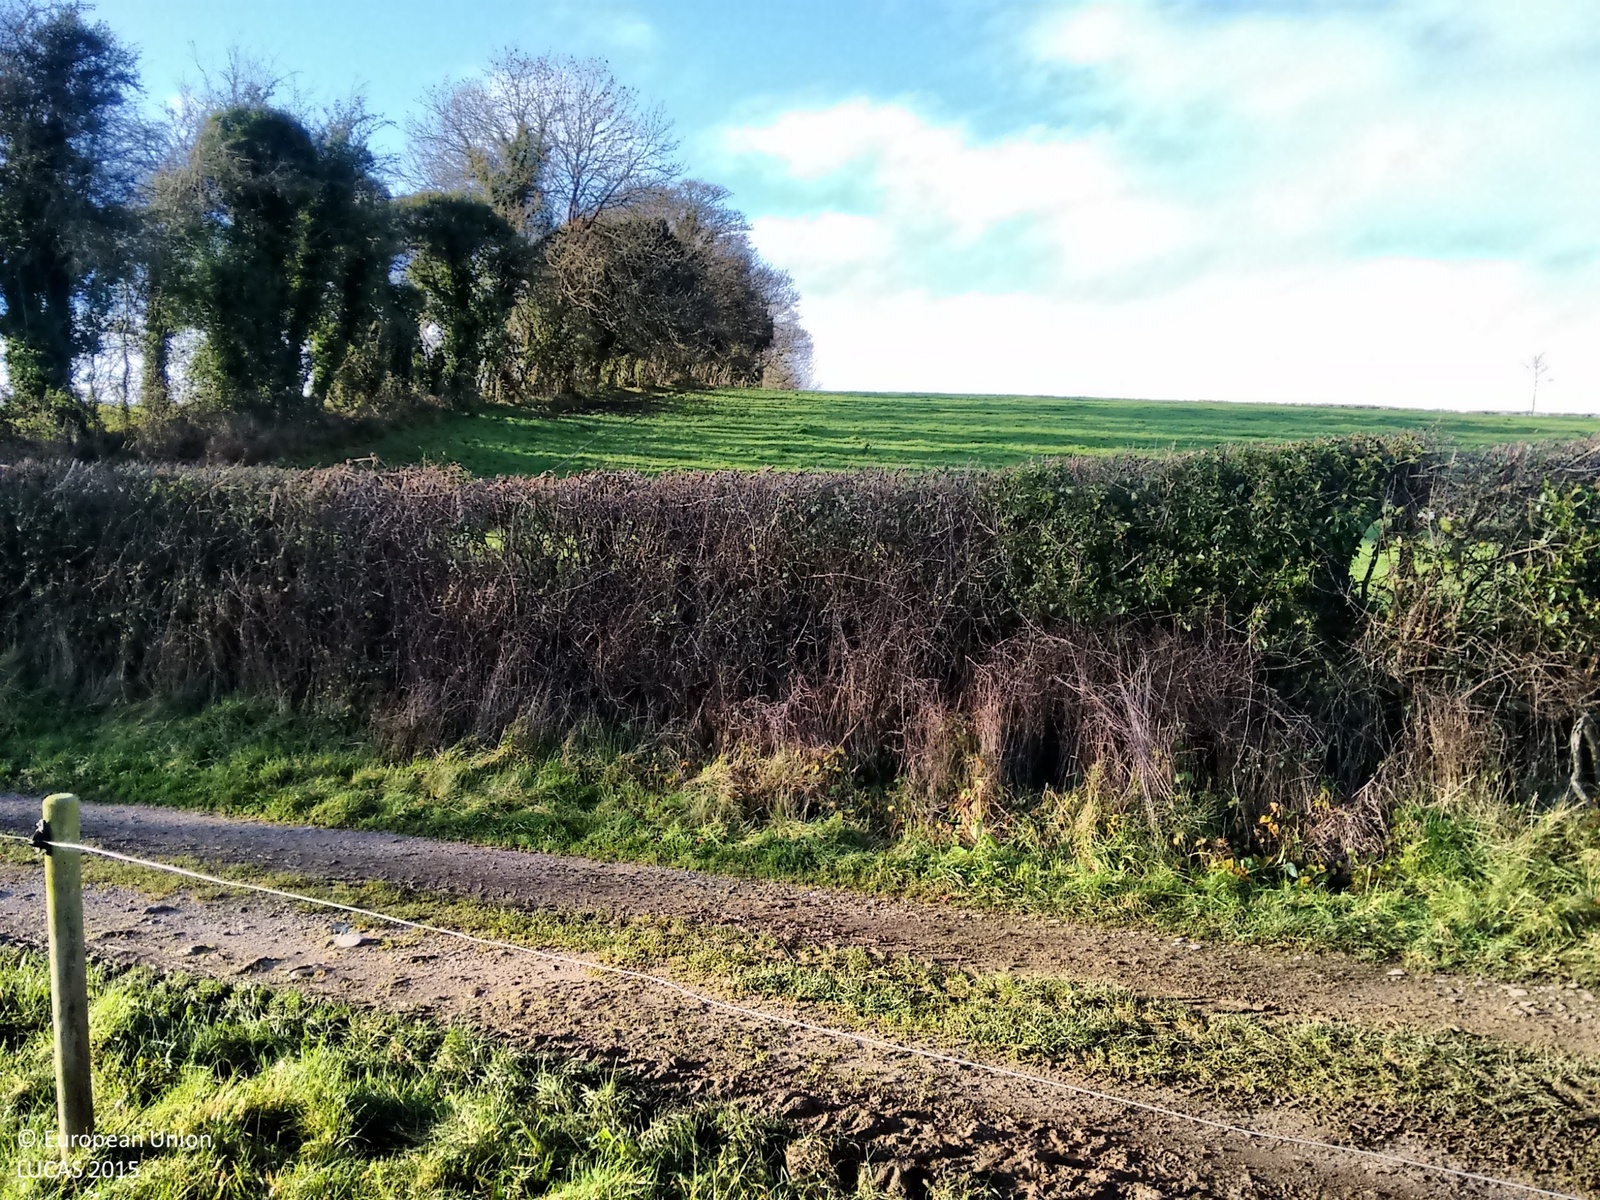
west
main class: Grassland
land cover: Grassland without tree/shrub cover
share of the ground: > 75 %
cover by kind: herbaceous plants 100 %
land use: Agriculture (excluding fallow land and kitchen gardens)
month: December
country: IE
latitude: 53.9068
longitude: -6.6770
